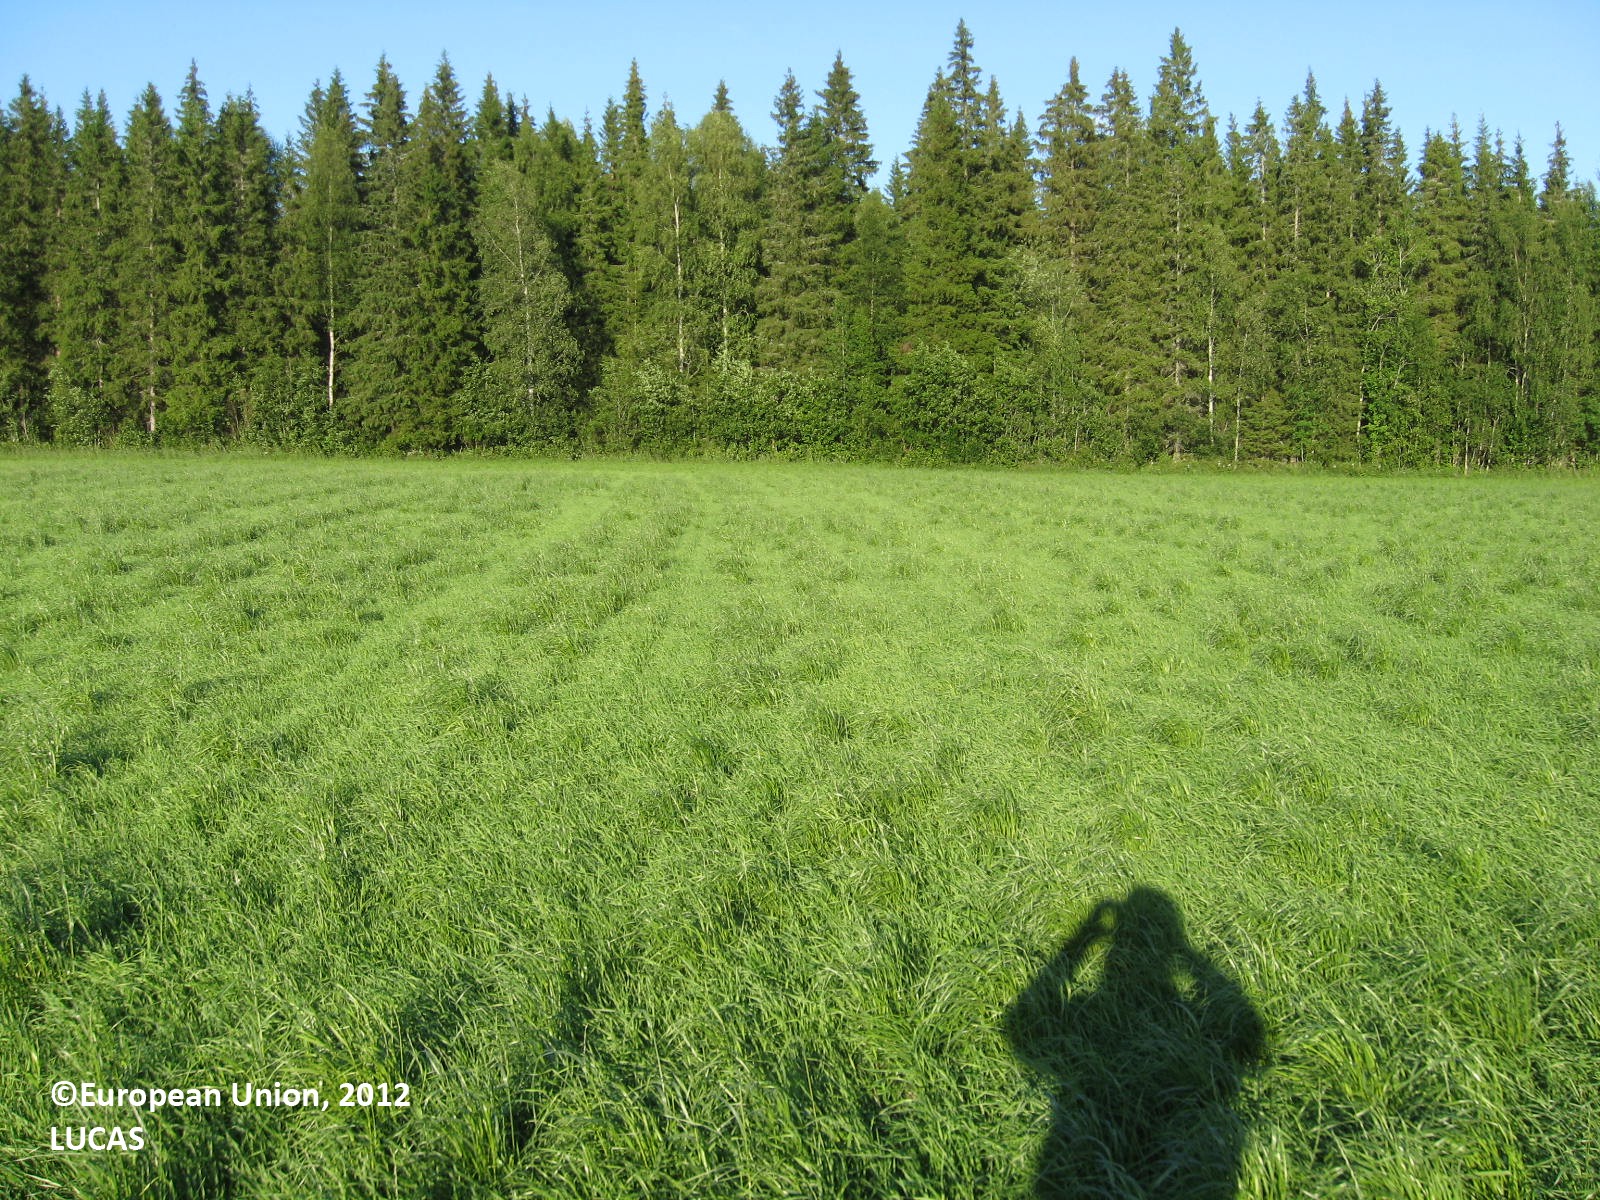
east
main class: Cropland
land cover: Temporary grasslands
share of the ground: > 75 %
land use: Agriculture (excluding fallow land and kitchen gardens)
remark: Harvested field
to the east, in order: Temporary grasslands; Barley; Grass margins; Ditches and canals; Pine dominated mixed woodland
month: July
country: FI
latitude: 62.3795
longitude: 21.6271
